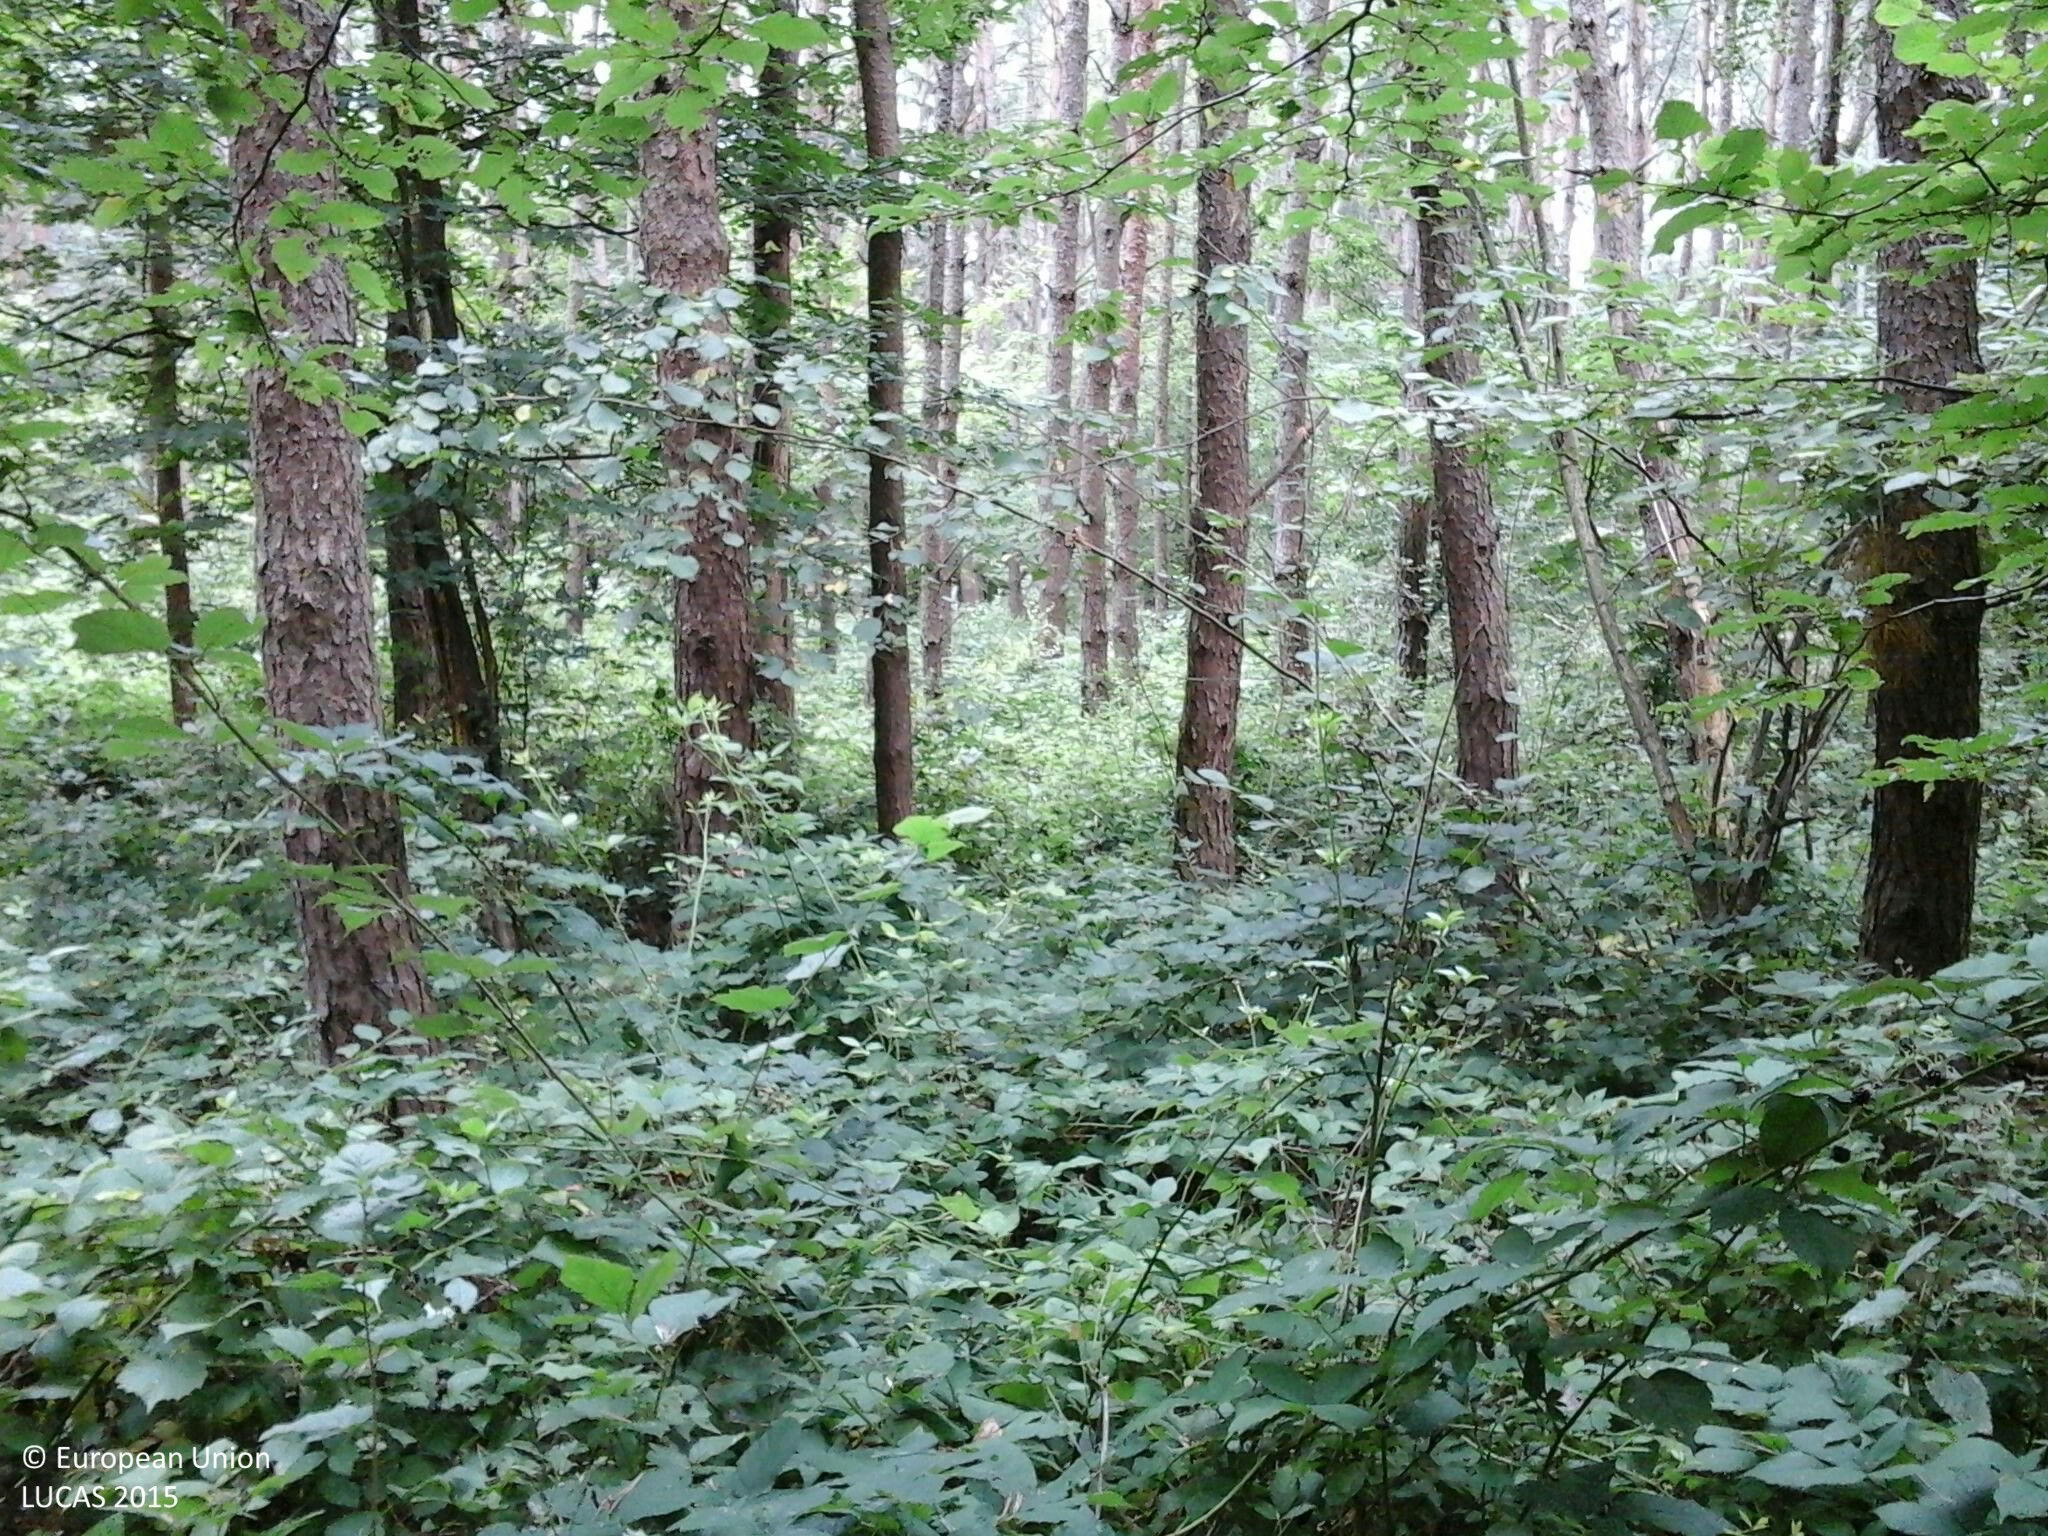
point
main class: Woodland
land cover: Other coniferous woodland
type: hemiboreal forest and nemoral coniferous forest and mixed broadleaved-coniferous forest
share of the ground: > 75 %
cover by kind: coniferous forest trees 60 %, shrubs 30 %, herbaceous plants 10 %
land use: Forestry
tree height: > 5 m
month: July
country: HU
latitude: 46.7476
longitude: 16.5337
